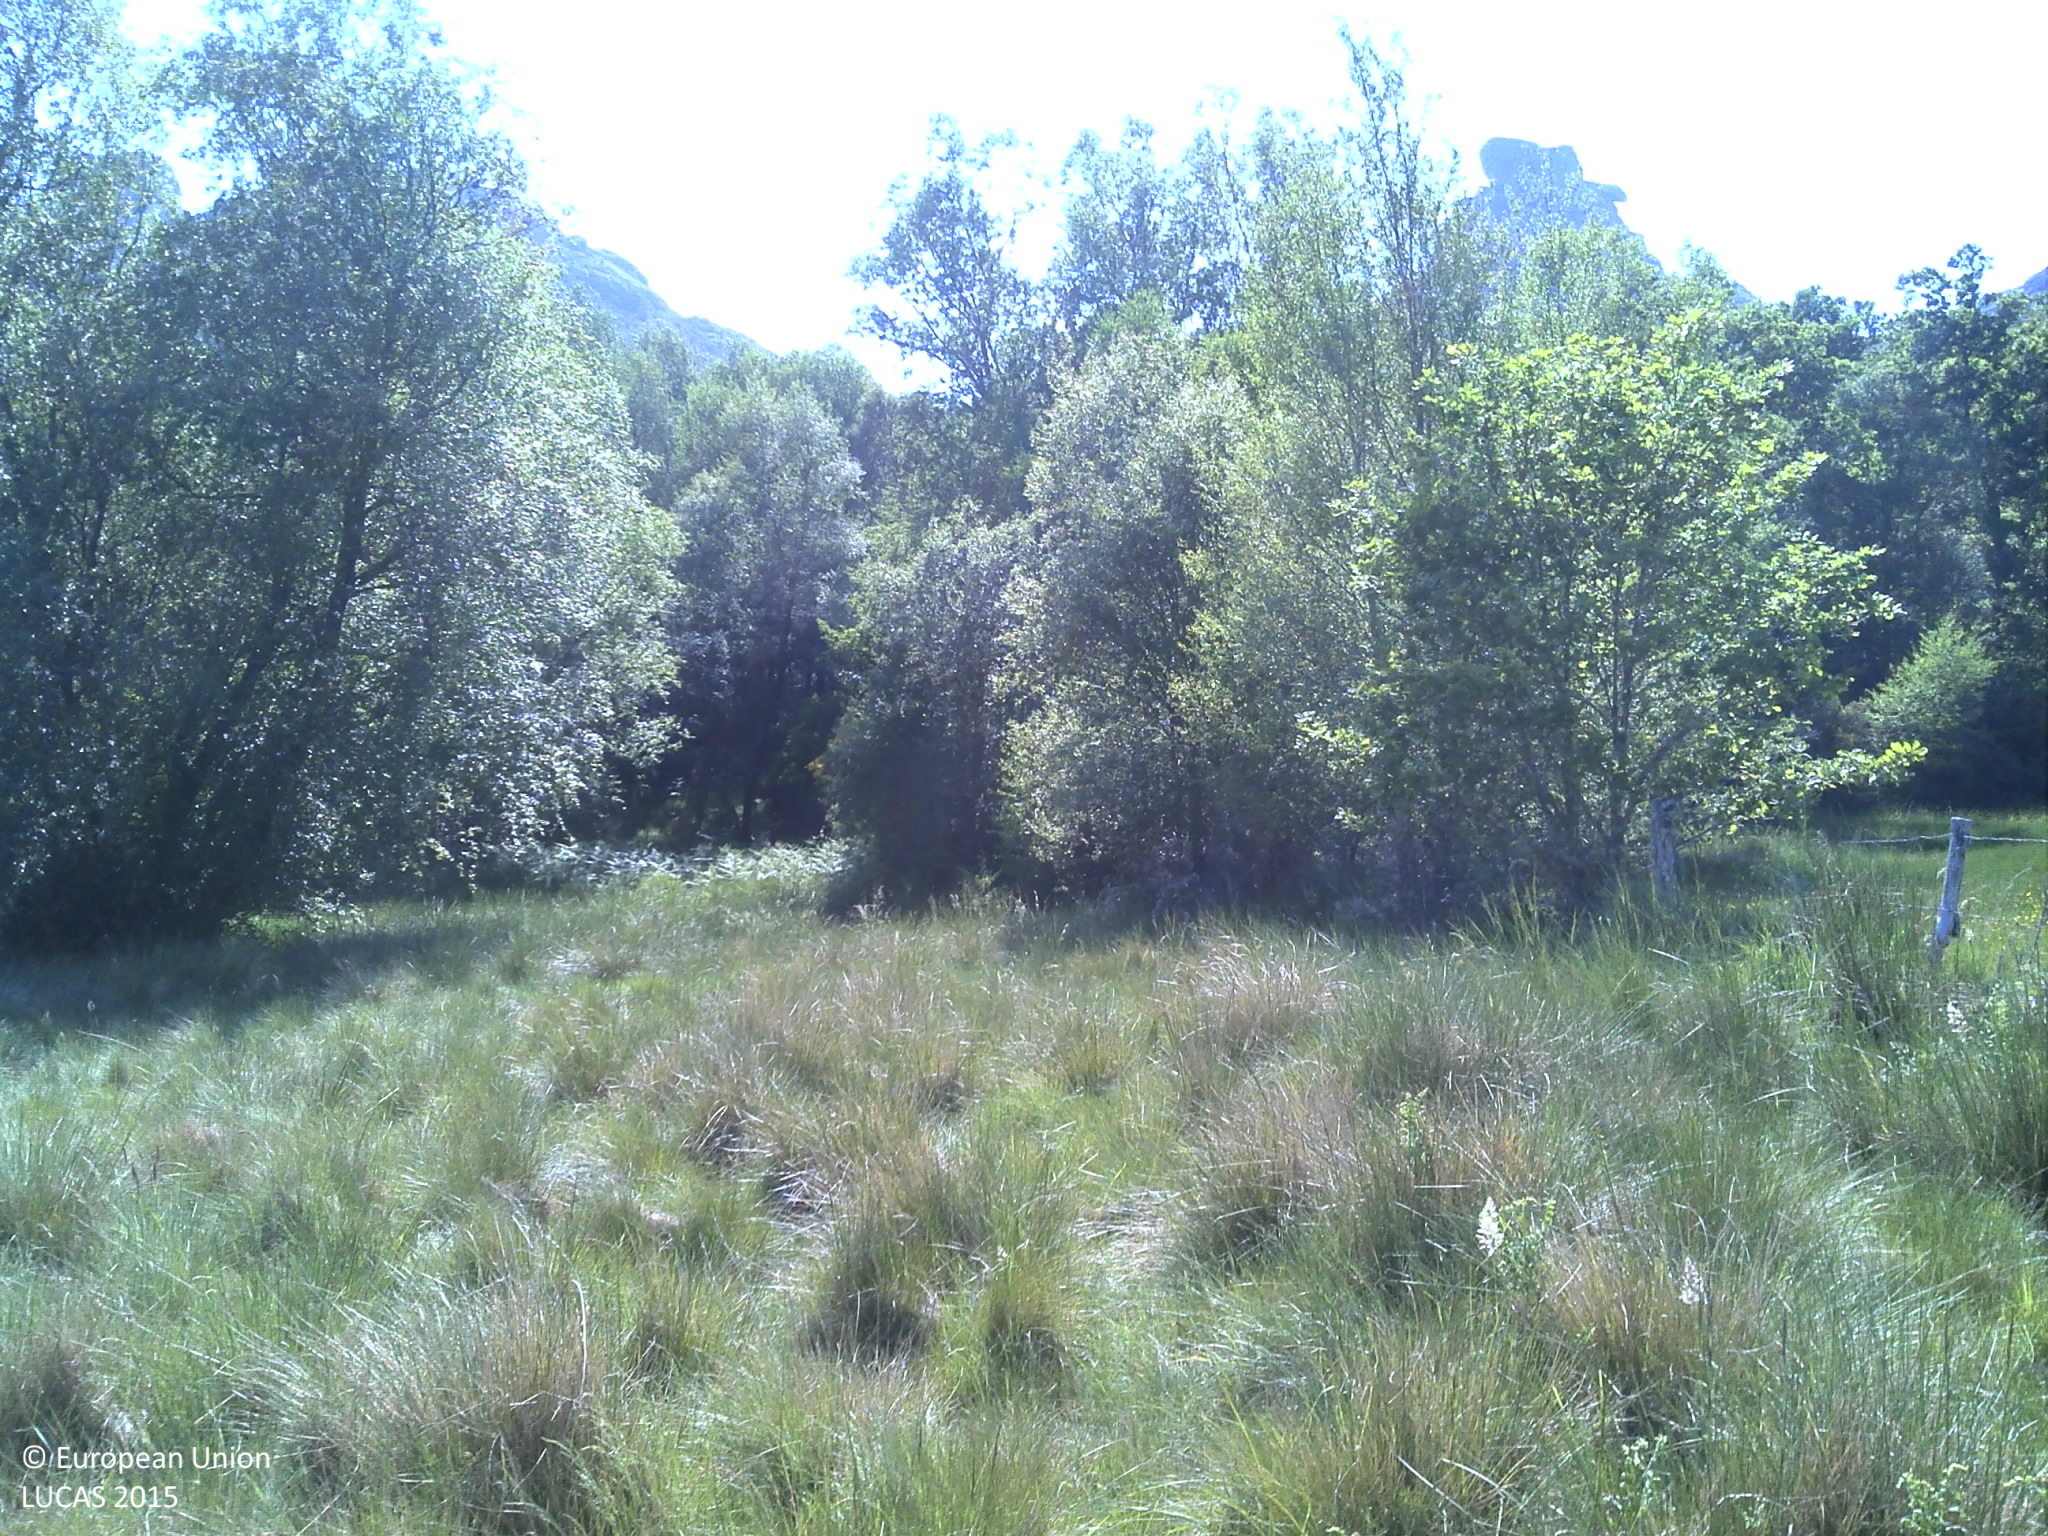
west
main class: Grassland
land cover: Grassland without tree/shrub cover
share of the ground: > 75 %
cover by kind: herbaceous plants 85 %, unconsolidated bare surface 15 %
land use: Agriculture (excluding fallow land and kitchen gardens)
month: June
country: PT
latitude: 42.0470
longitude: -8.1681
